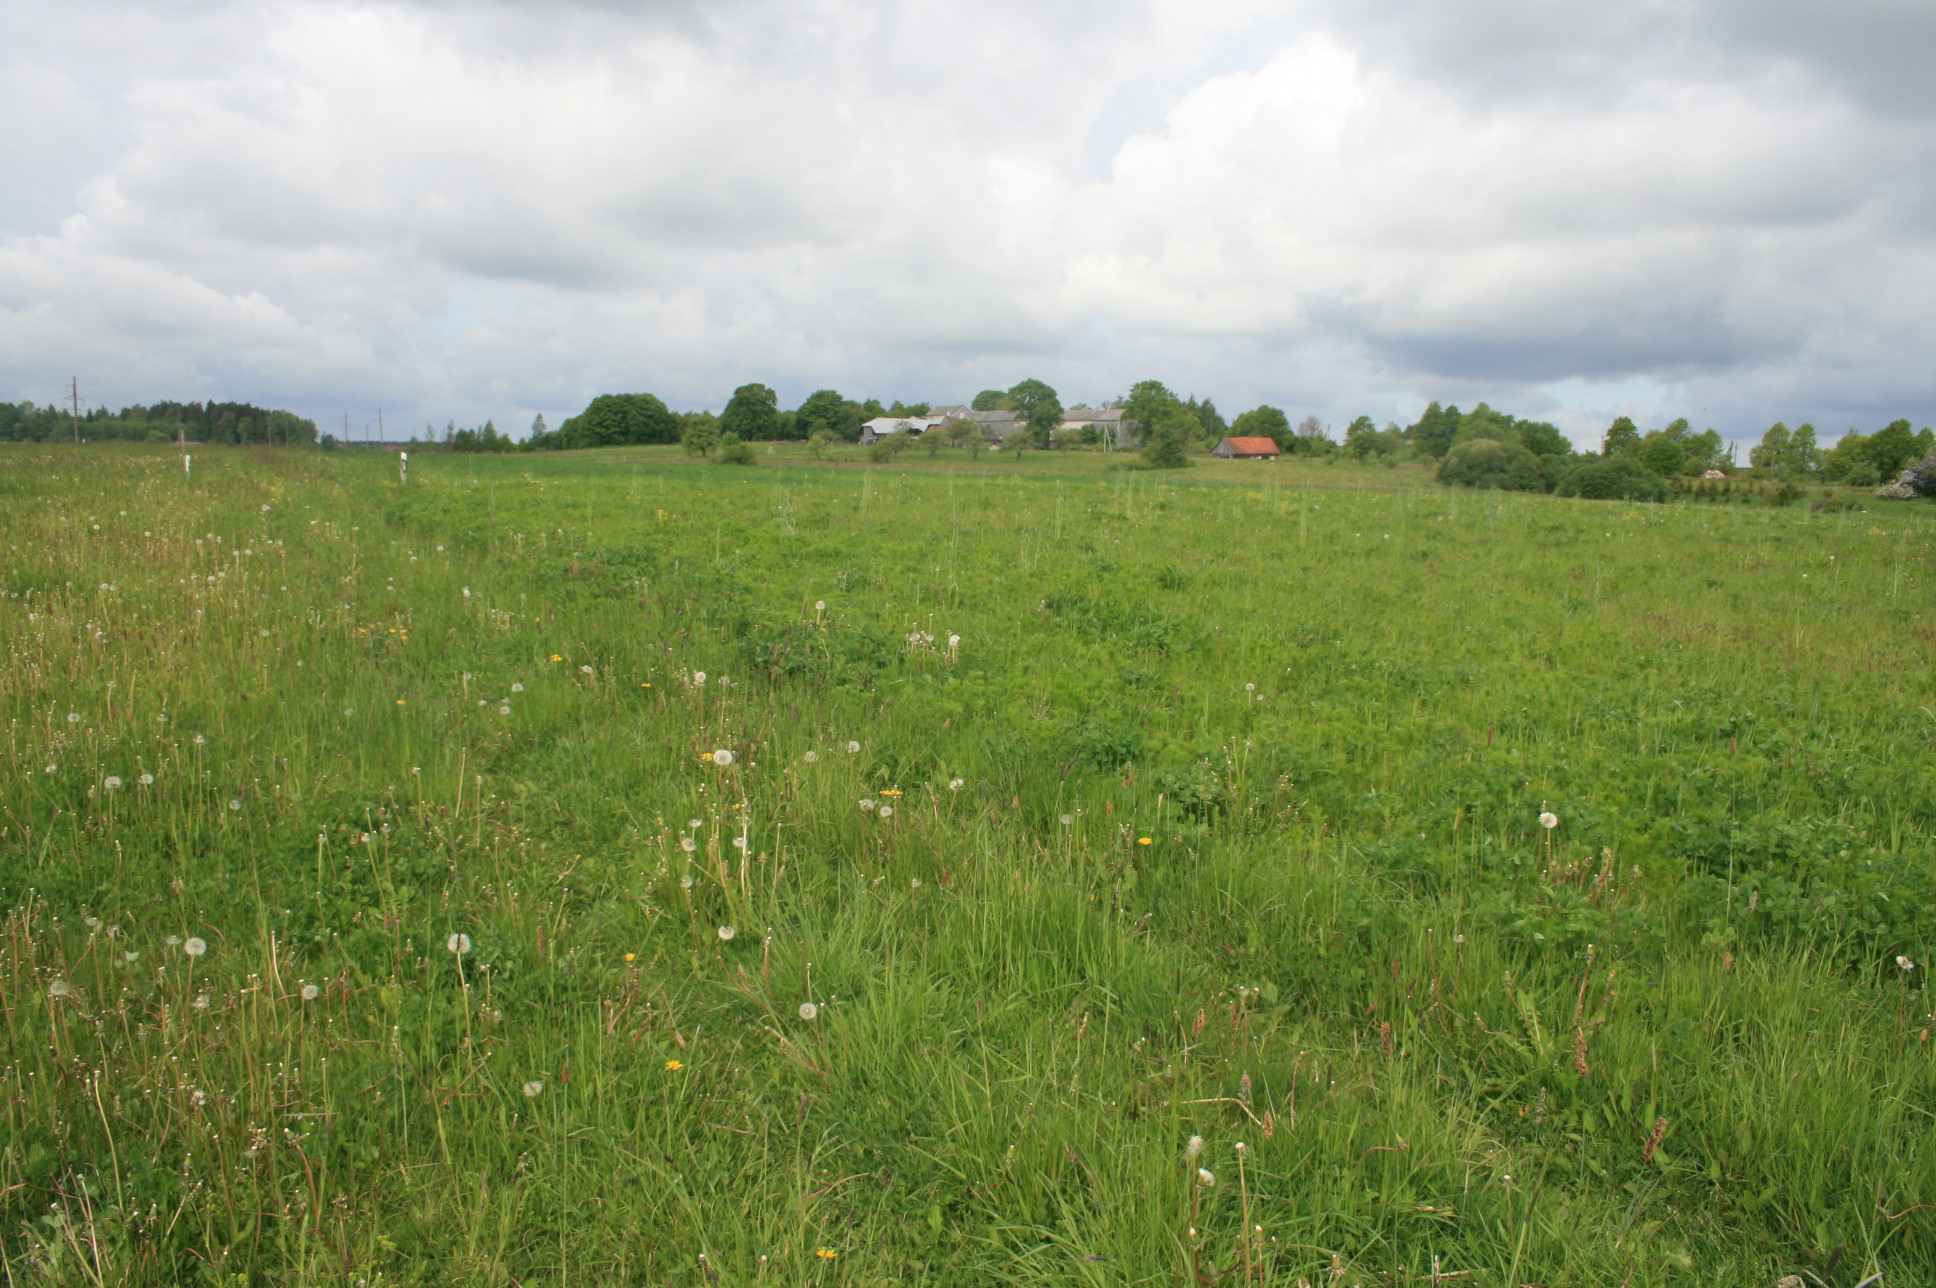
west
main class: Grassland
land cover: Grassland without tree/shrub cover
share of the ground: > 75 %
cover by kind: herbaceous plants 100 %
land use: Agriculture (excluding fallow land and kitchen gardens)
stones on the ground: < 10 %
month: May
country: LT
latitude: 55.7392
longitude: 21.9170
